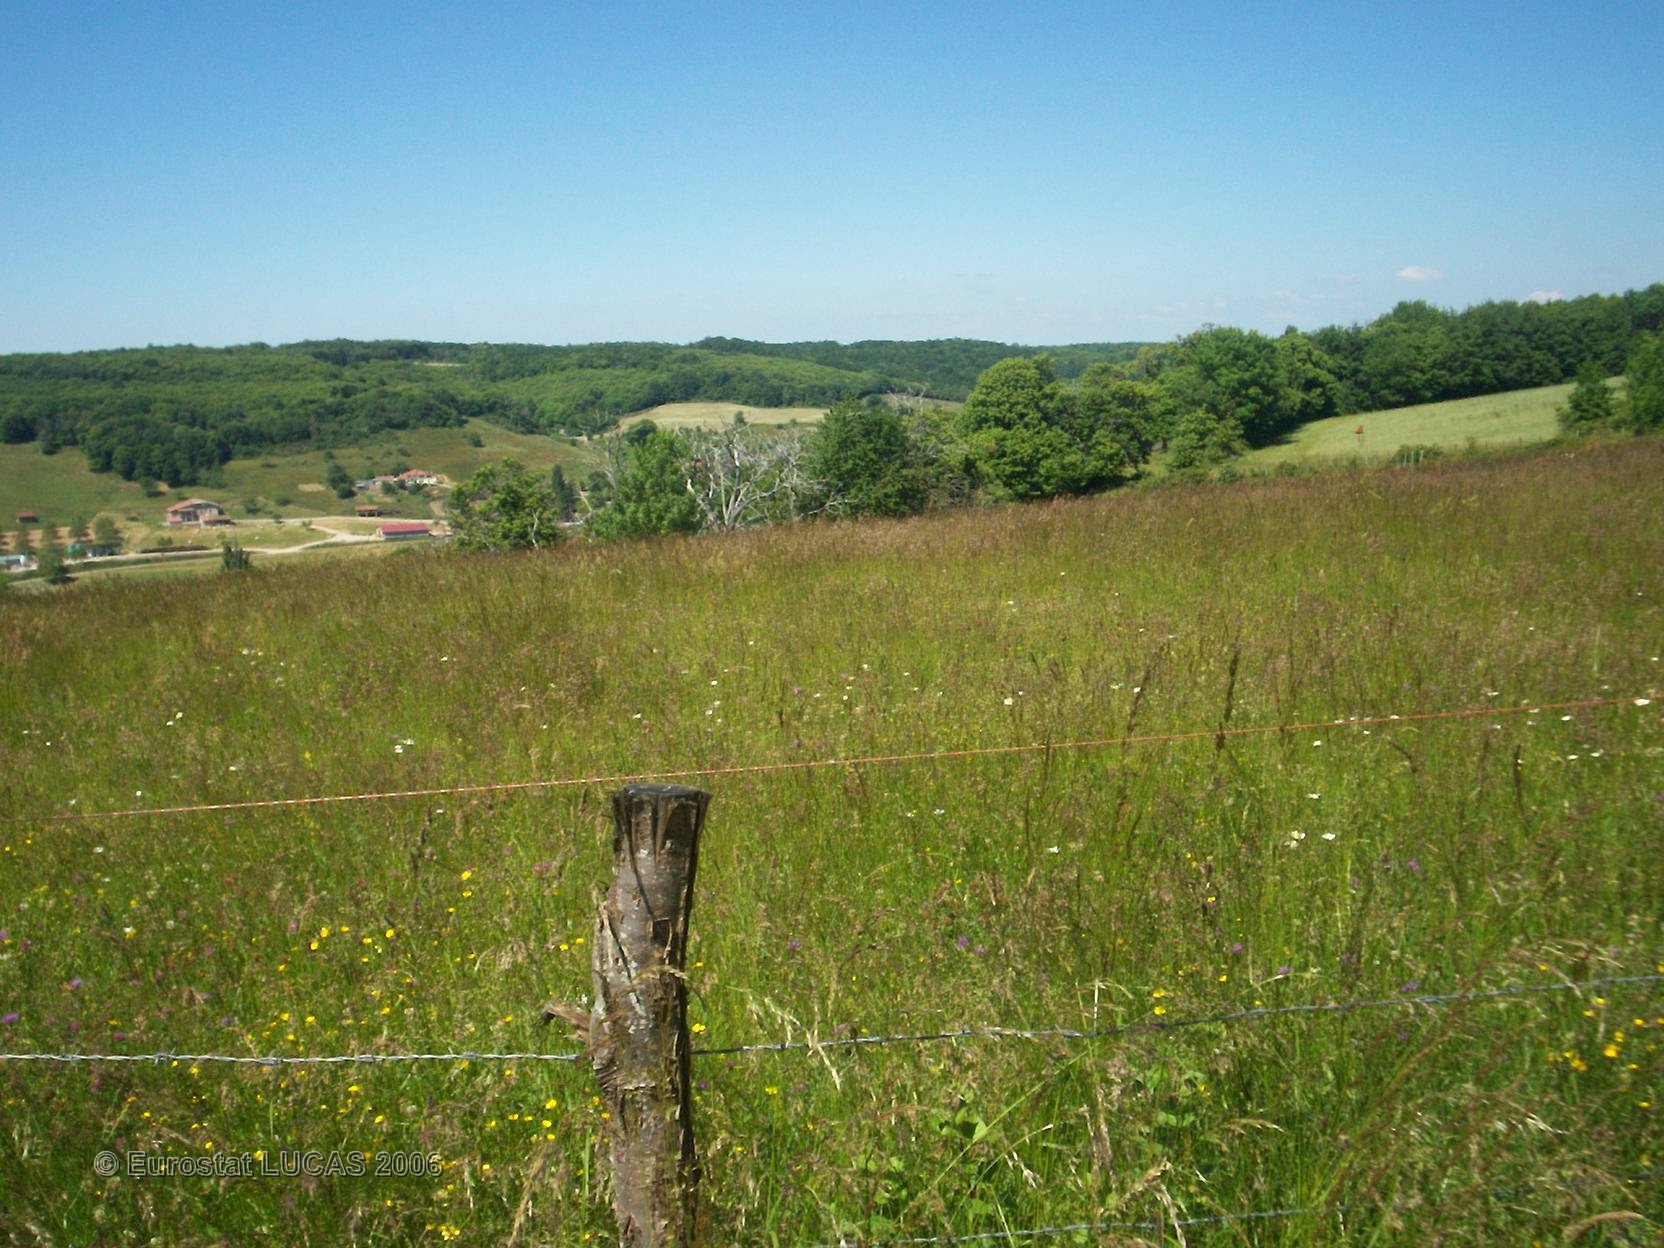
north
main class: Grassland
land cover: Grassland without tree/shrub cover
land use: Agriculture (excluding fallow land and kitchen gardens)
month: June
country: FR
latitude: 45.1946
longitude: 5.1554
